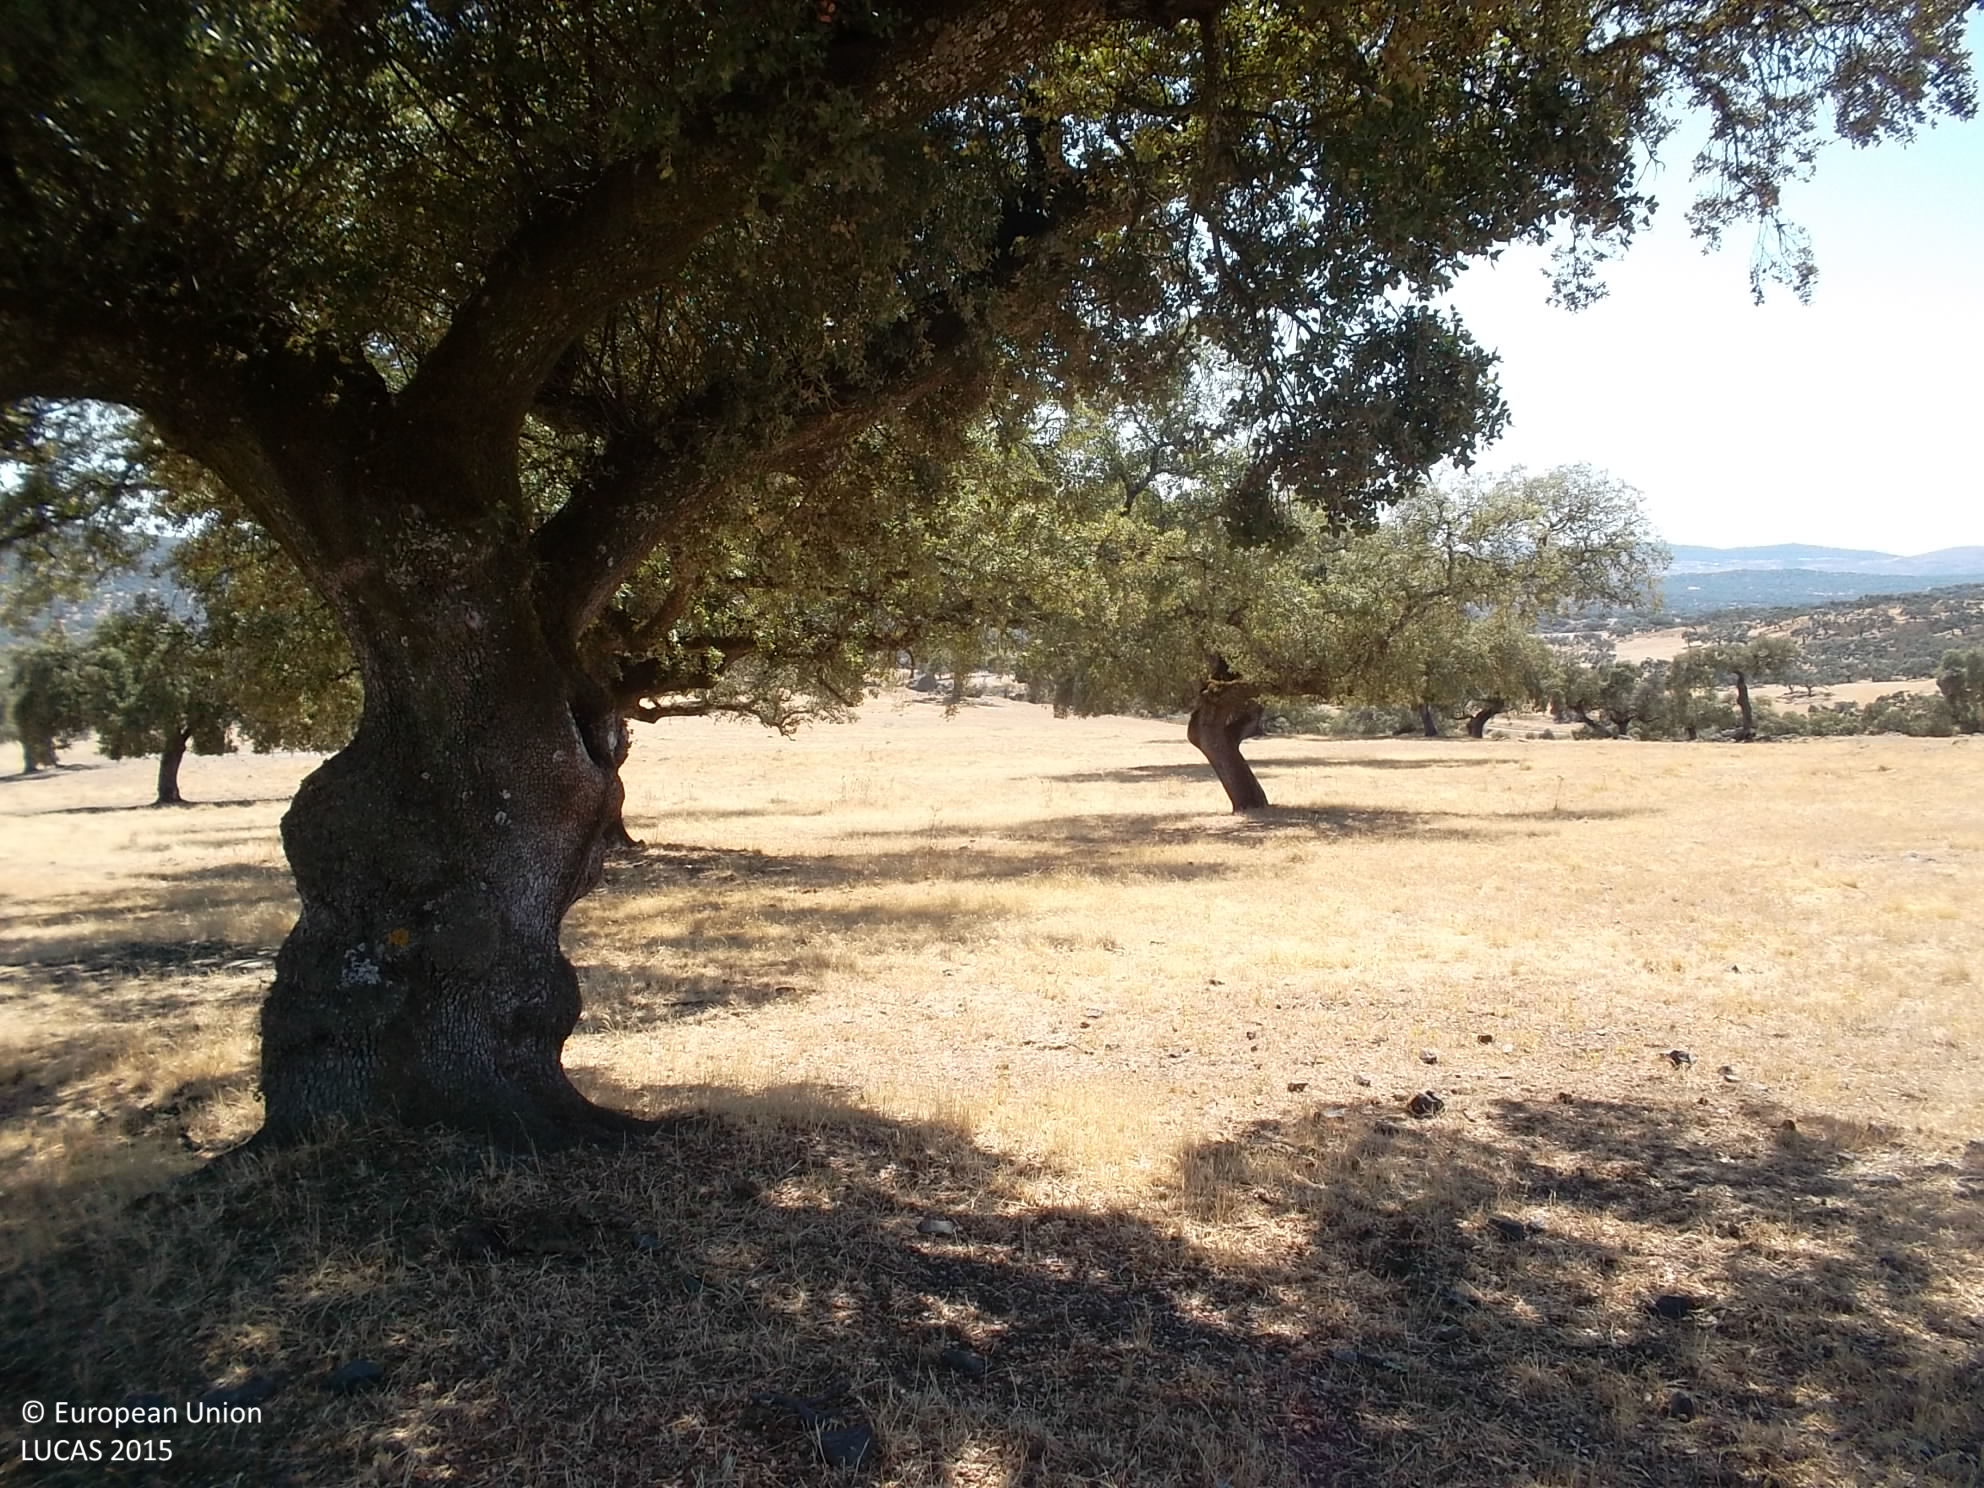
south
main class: Woodland
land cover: Broadleaved woodland
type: broadleaved evergreen forest
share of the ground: 10 - 25 %
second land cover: Grassland without tree/shrub cover
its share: > 75 %
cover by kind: herbaceous plants 85 %, broadleaved forest trees 15 %
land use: Forestry
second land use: Agriculture (excluding fallow land and kitchen gardens)
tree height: > 5 m
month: August
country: ES
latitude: 38.4330
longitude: -6.7247
